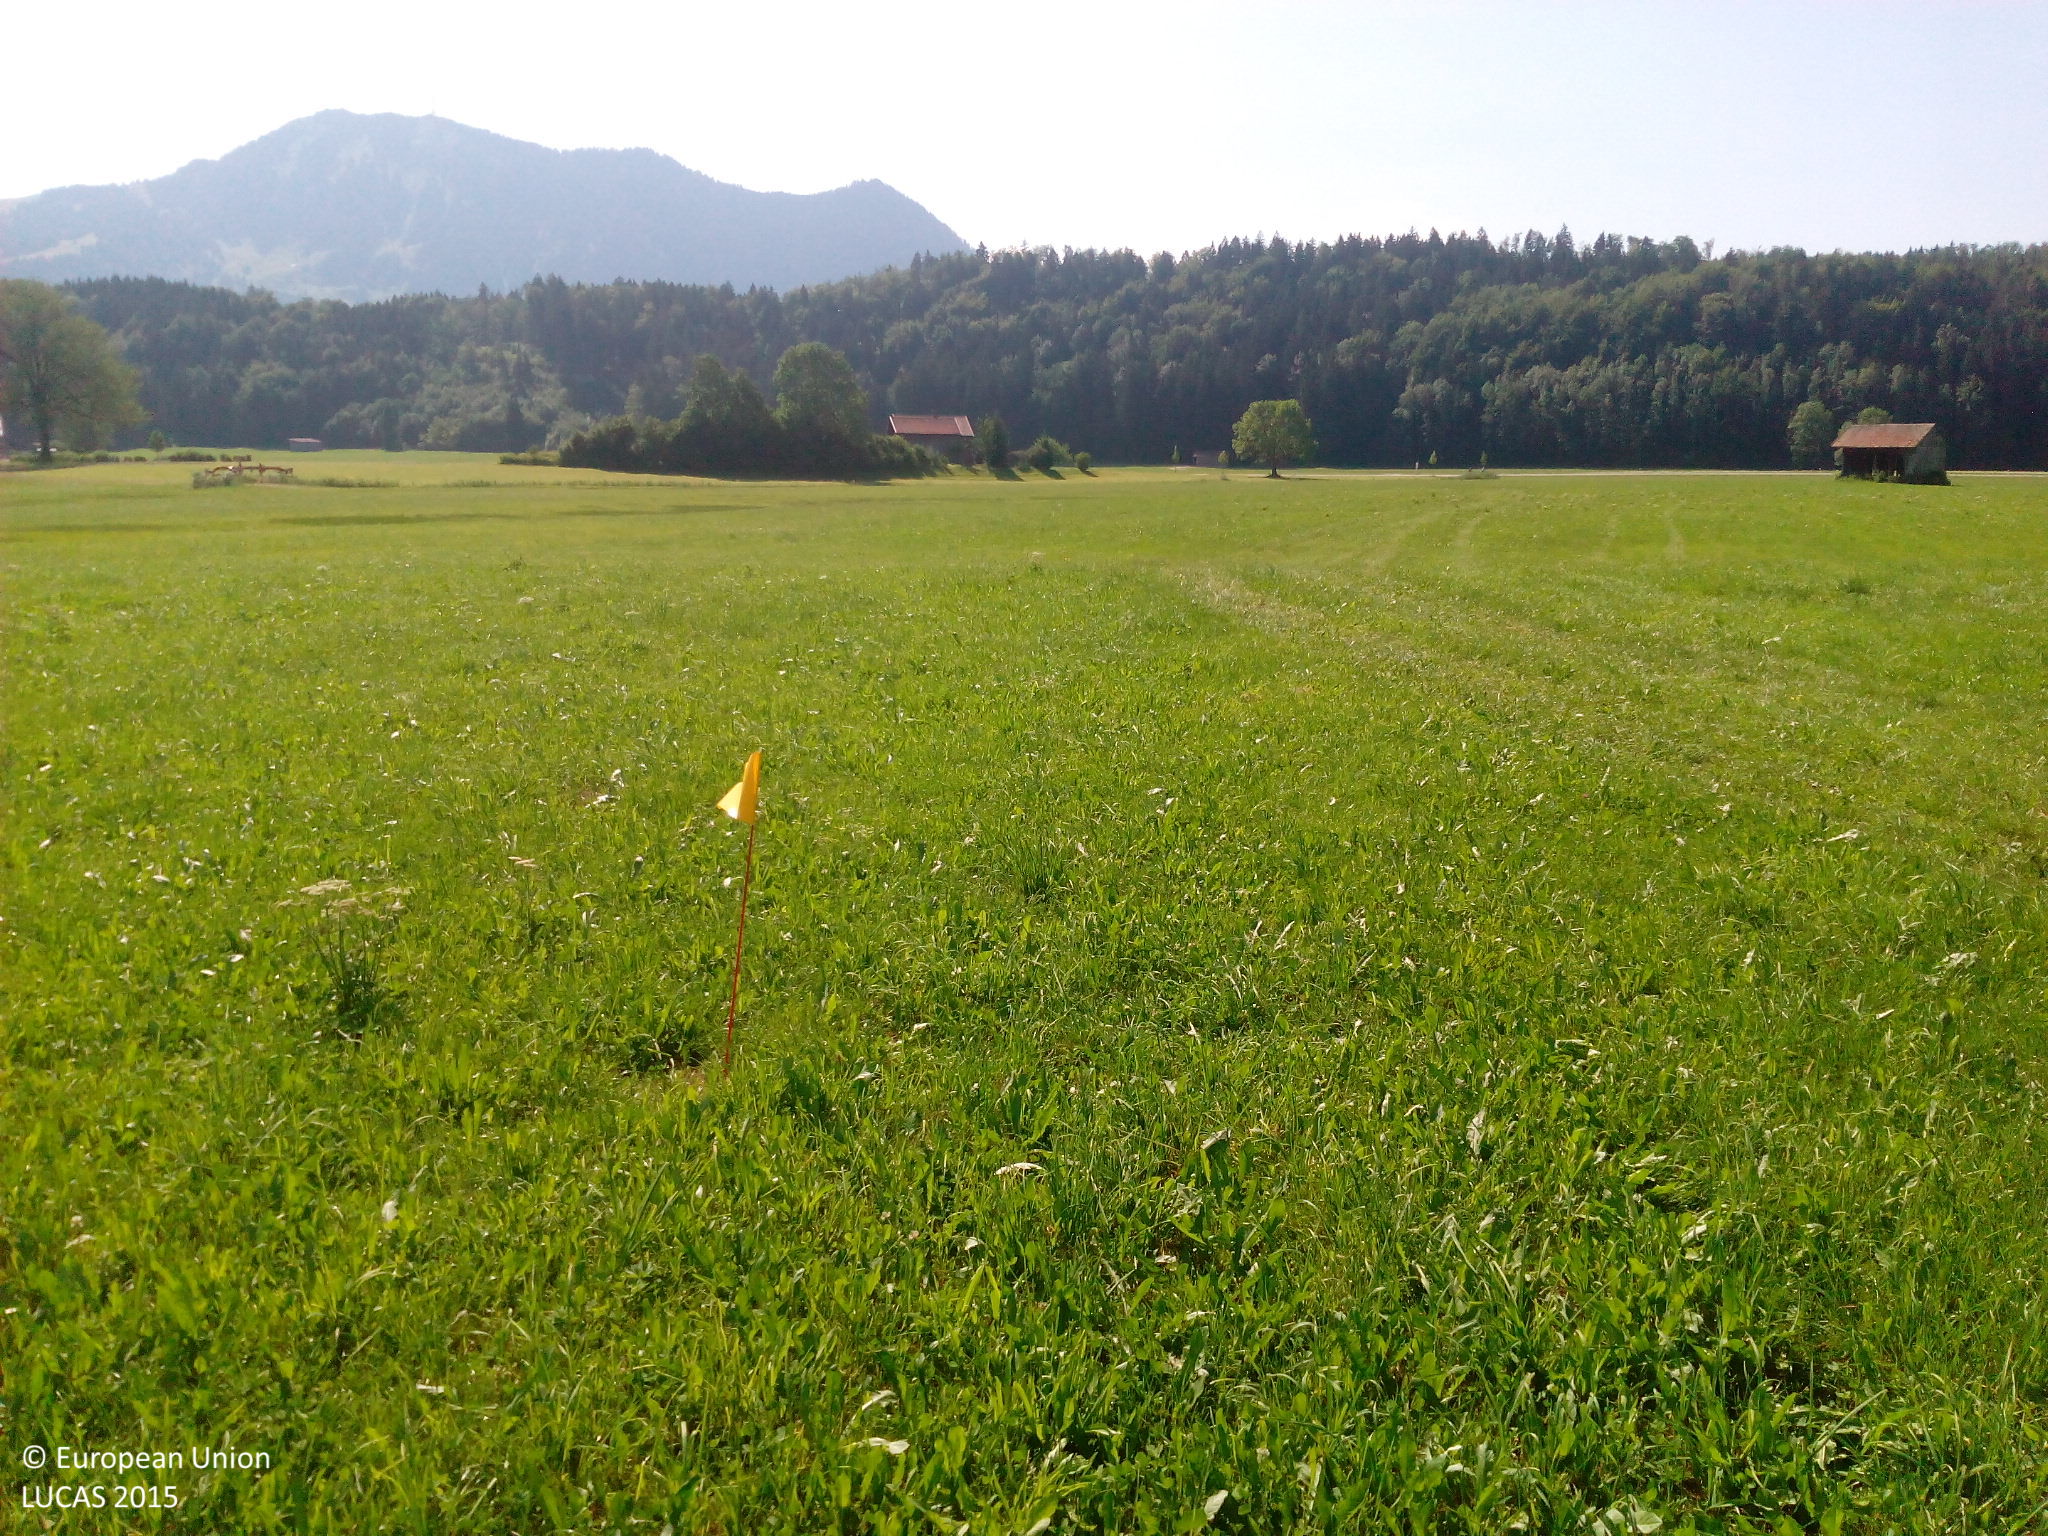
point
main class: Grassland
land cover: Grassland without tree/shrub cover
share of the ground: > 75 %
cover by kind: herbaceous plants 100 %
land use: Agriculture (excluding fallow land and kitchen gardens)
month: July
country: DE
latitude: 47.5753
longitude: 10.2524
